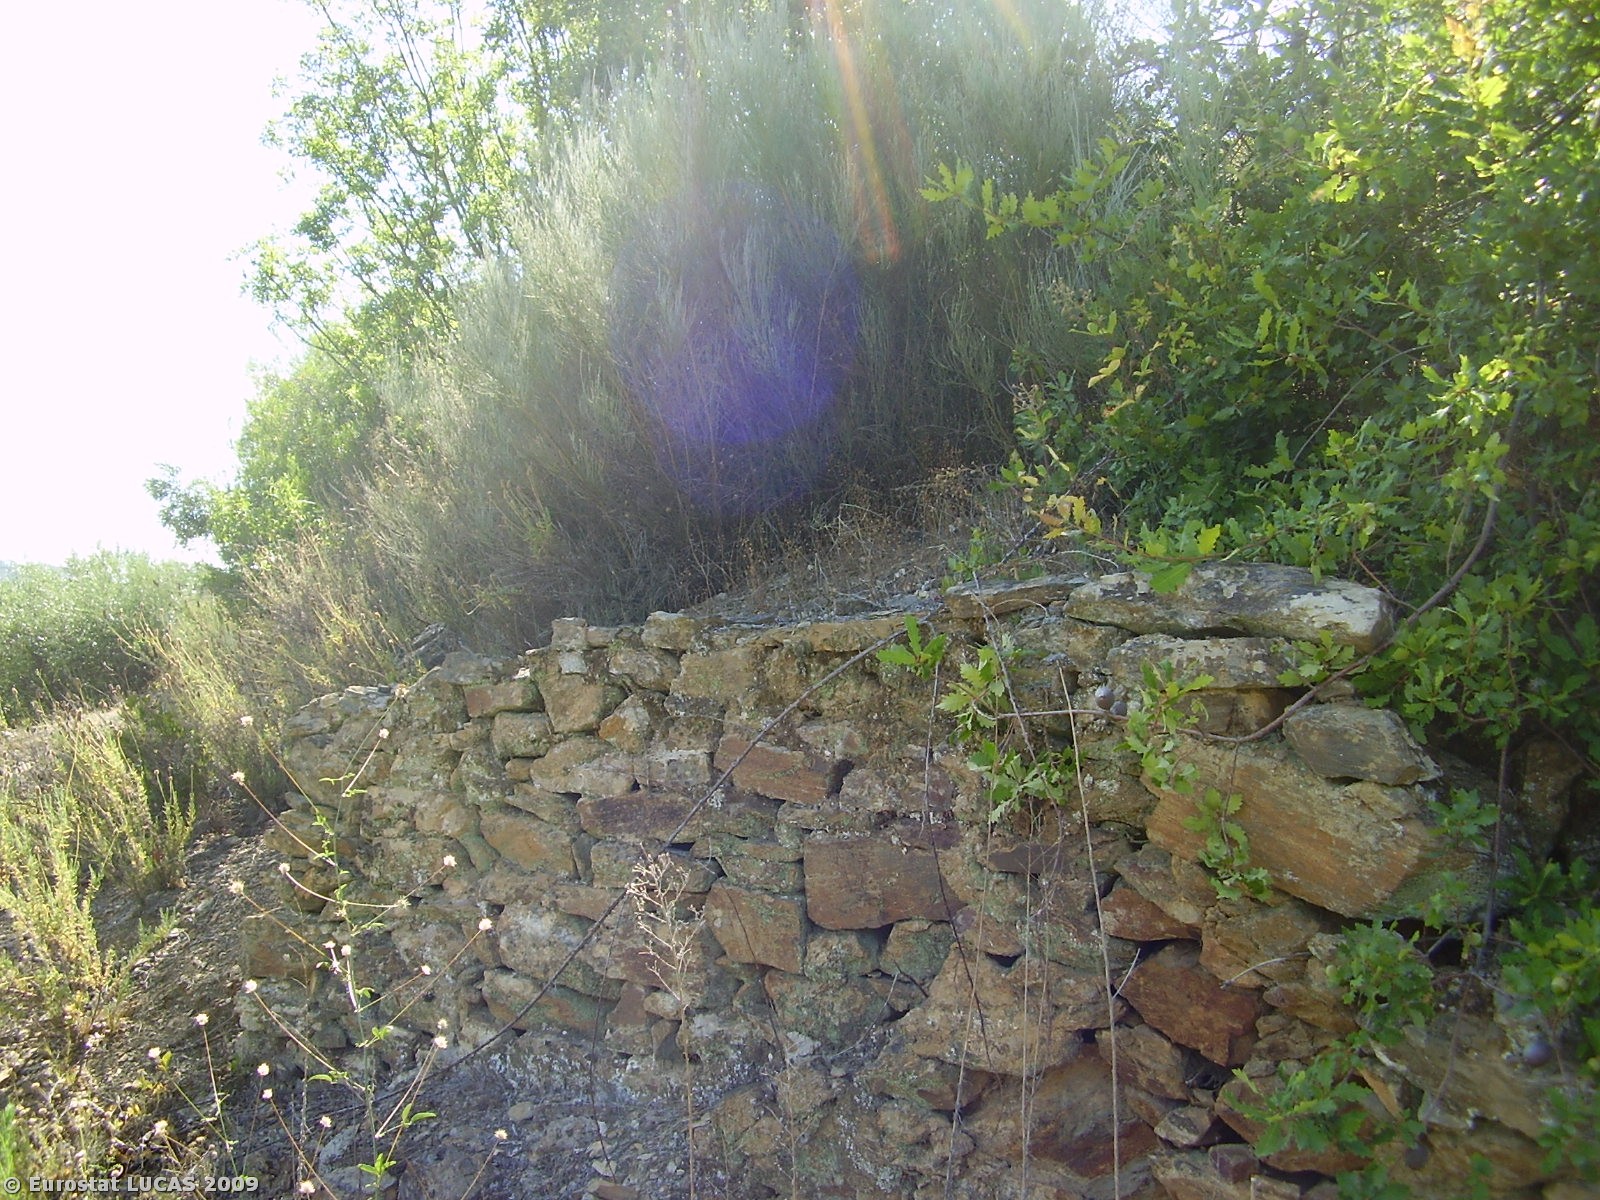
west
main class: Cropland
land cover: Vineyards
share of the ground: < 10 %
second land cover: Spontaneously vegetated surfaces
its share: 10 - 25 %
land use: Agriculture (excluding fallow land and kitchen gardens)
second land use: Unused
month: July
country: PT
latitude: 41.2748
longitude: -7.5426
